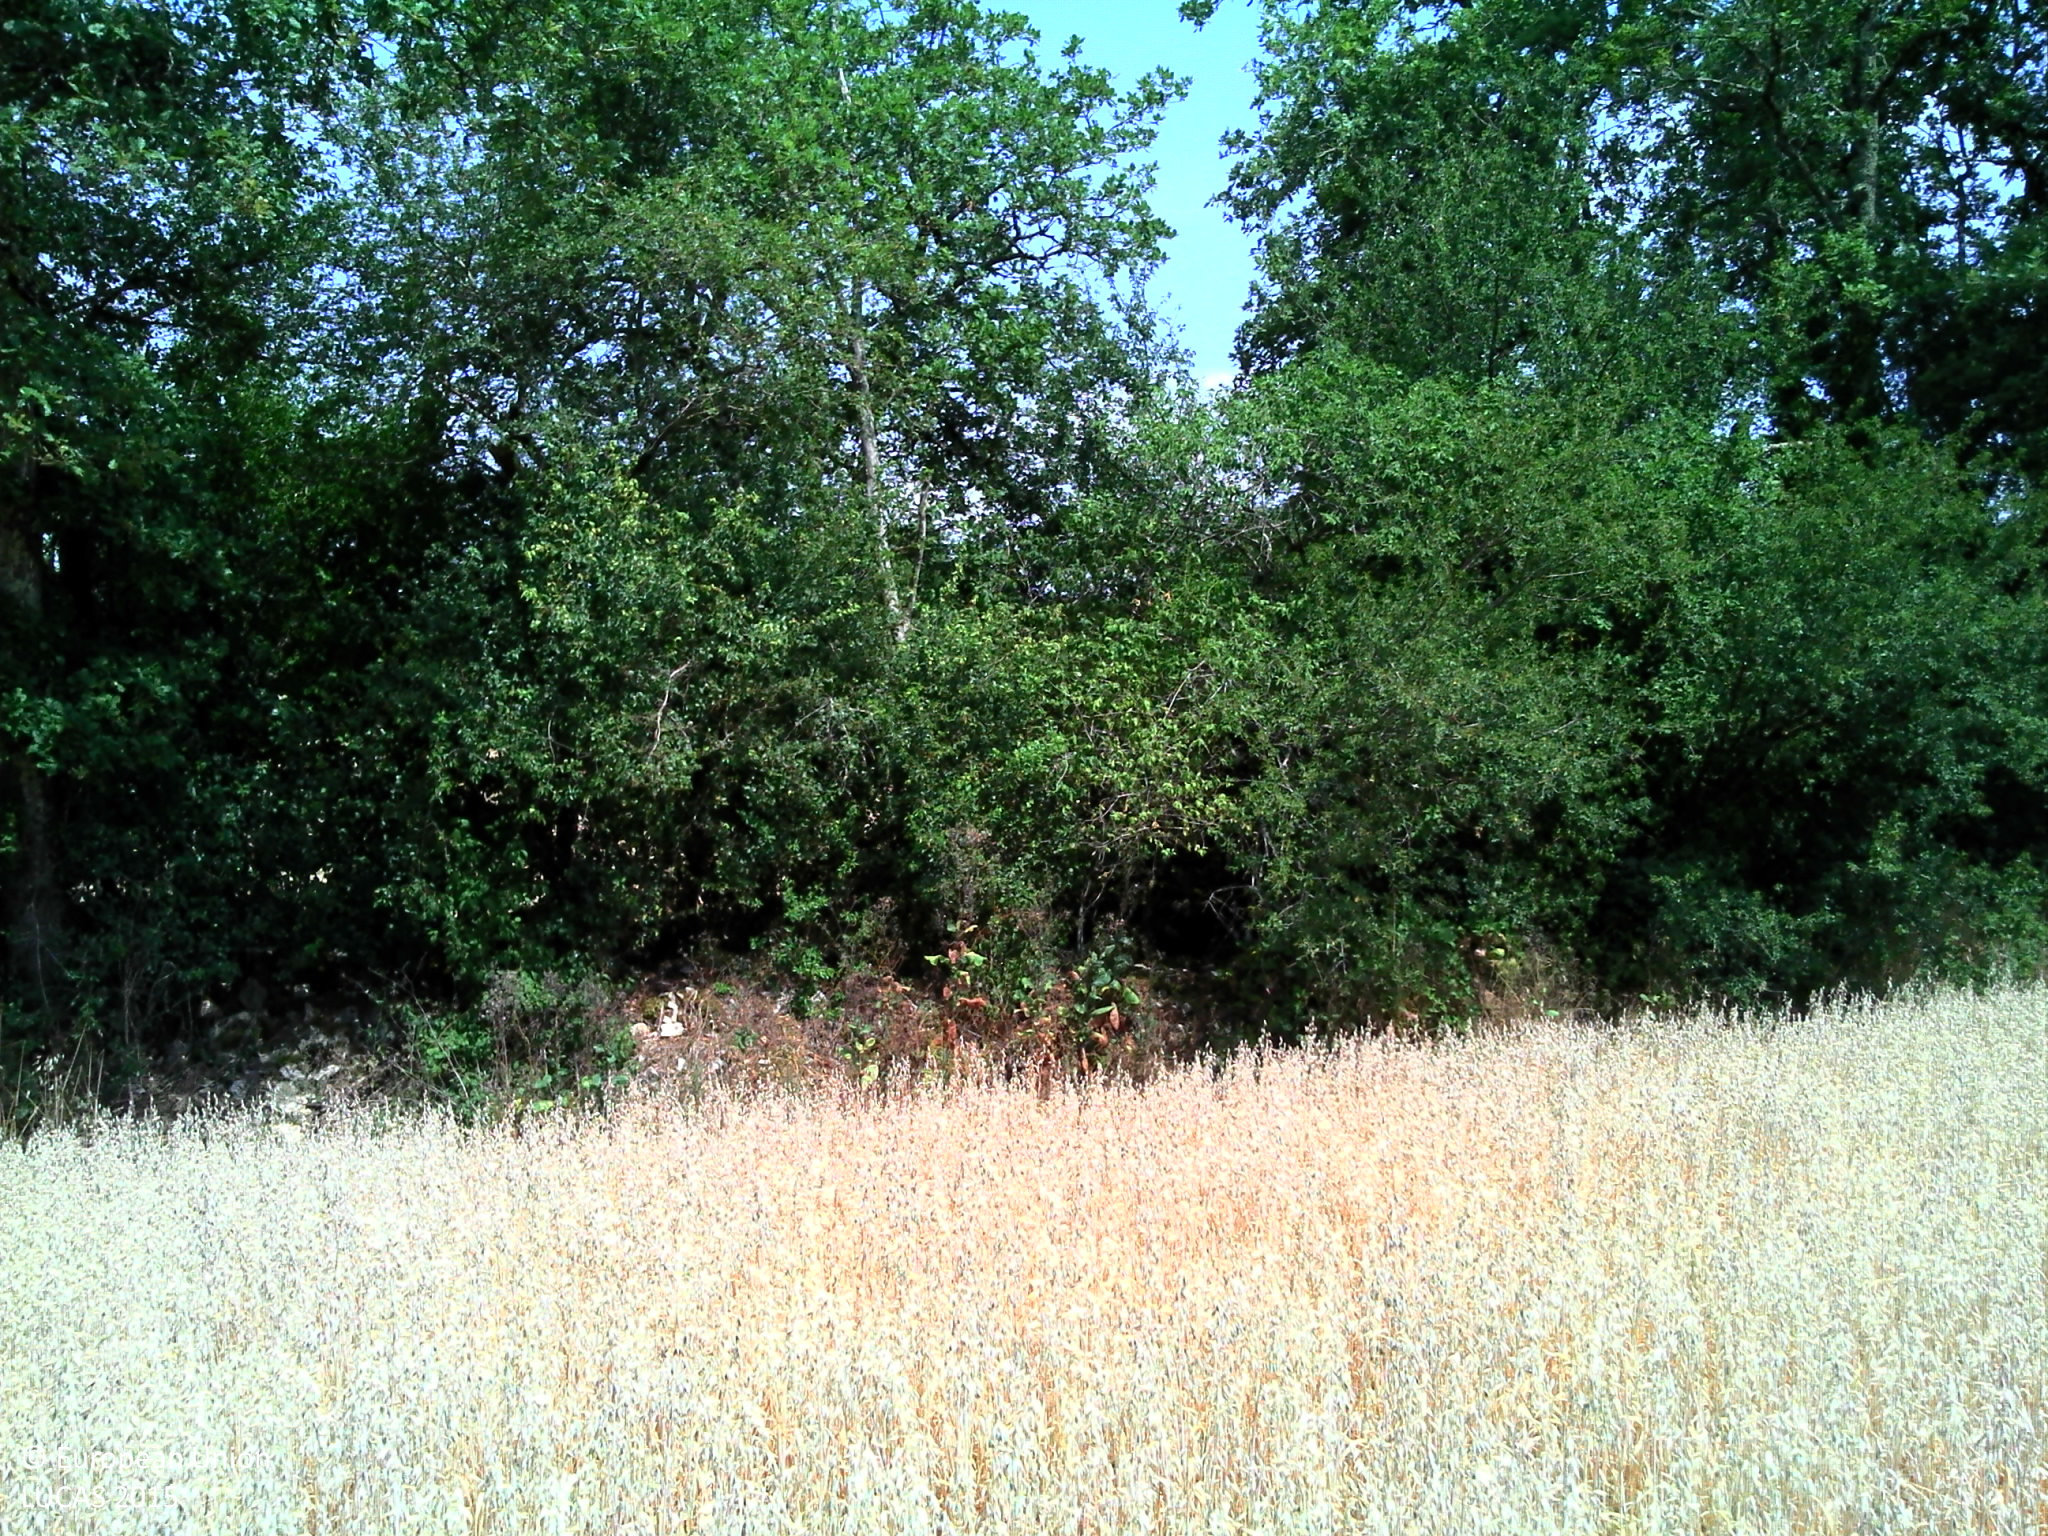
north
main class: Cropland
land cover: Oats
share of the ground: > 75 %
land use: Agriculture (excluding fallow land and kitchen gardens)
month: July
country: FR
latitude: 45.1978
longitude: 1.0689
